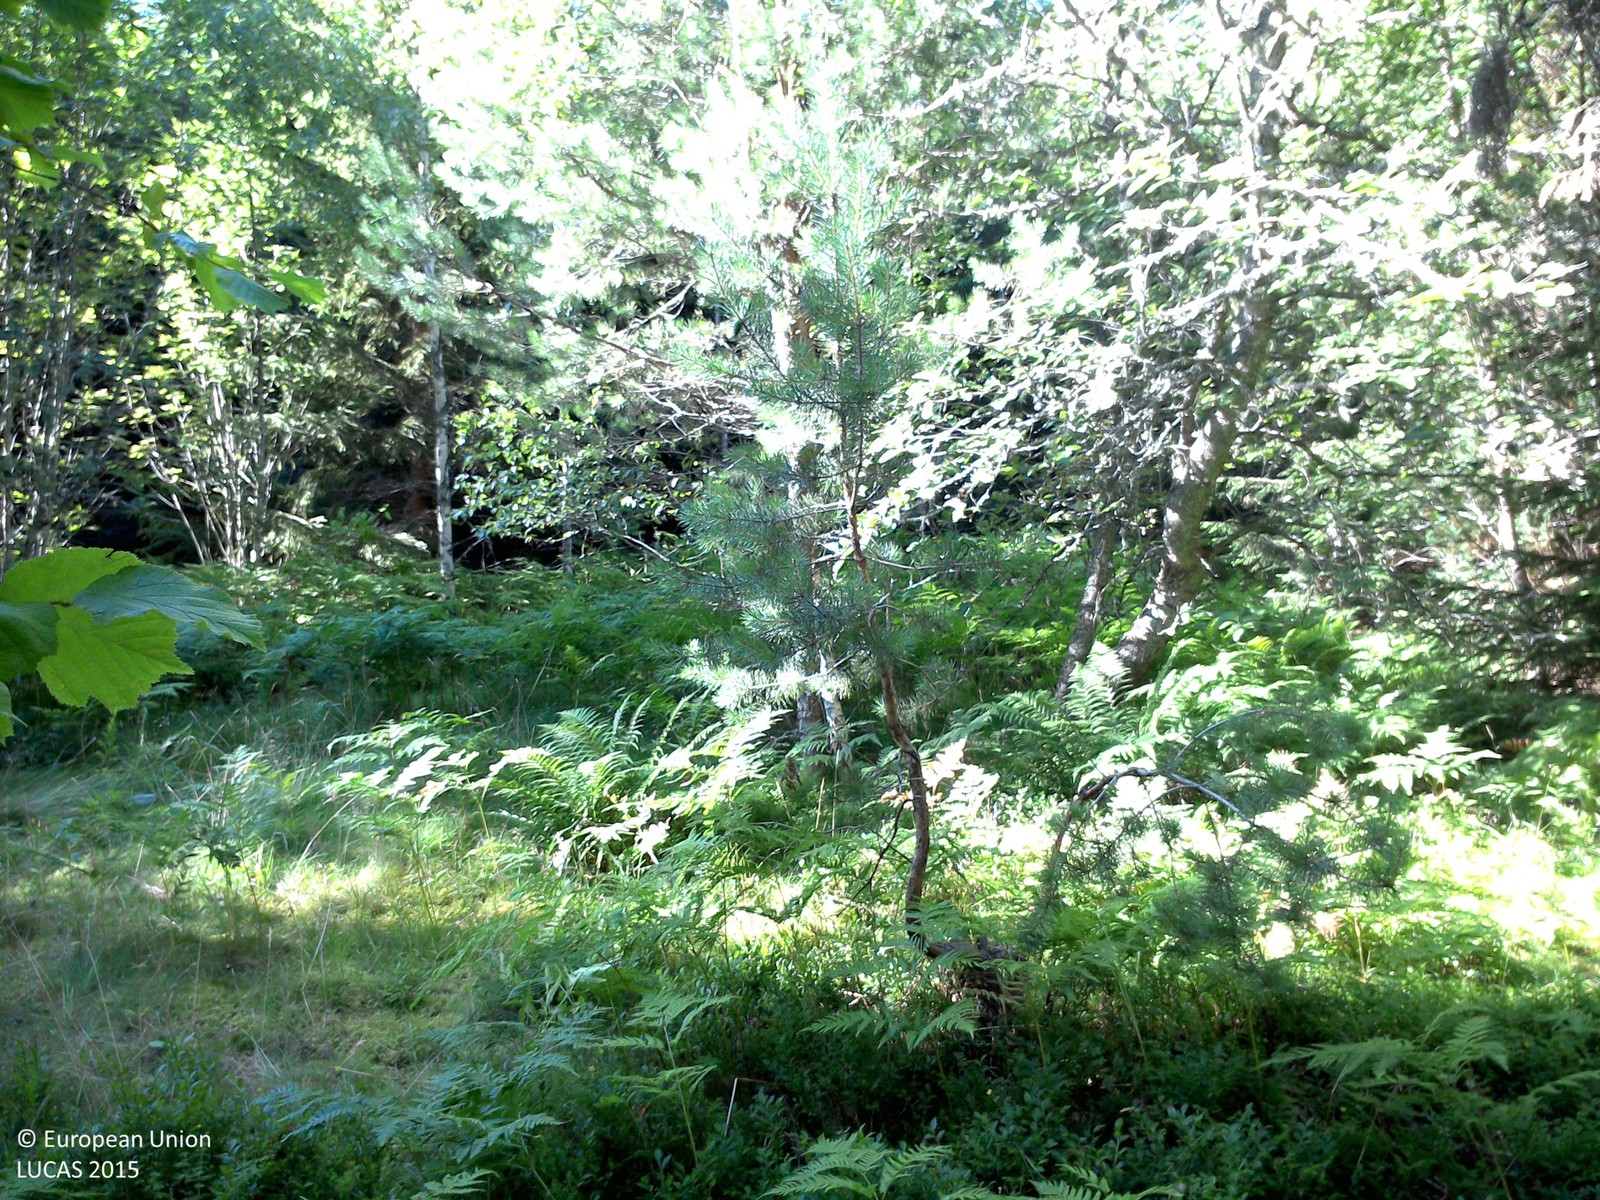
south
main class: Woodland
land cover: Spruce dominated mixed woodland
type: boreal forest
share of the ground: 50 - 75 %
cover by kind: coniferous forest trees 50 %, herbaceous plants 30 %, broadleaved forest trees 20 %
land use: Forestry
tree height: > 5 m
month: August
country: SE
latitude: 58.0906
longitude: 14.9985
